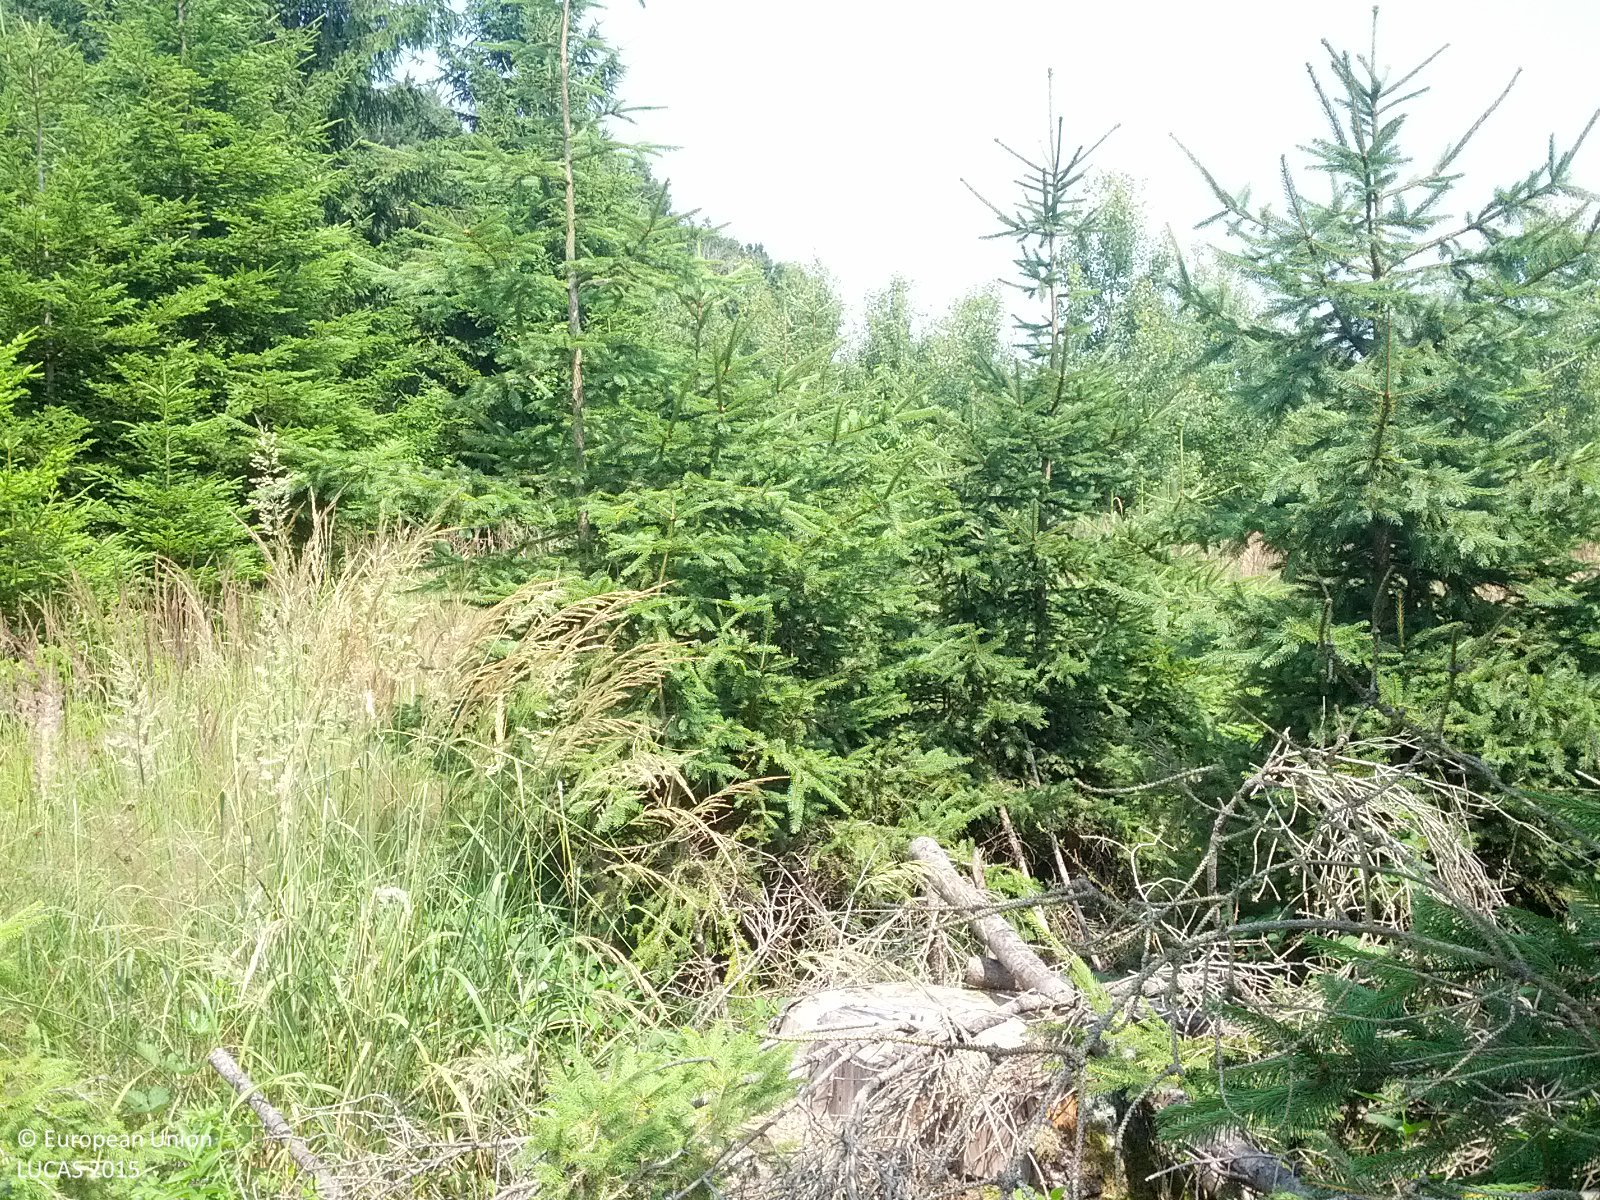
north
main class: Woodland
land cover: Spruce dominated coniferous woodland
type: alpine coniferous forest
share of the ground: > 75 %
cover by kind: coniferous forest trees 80 %, herbaceous plants 10 %, unconsolidated bare surface 10 %
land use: Forestry
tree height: > 5 m
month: July
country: AT
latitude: 47.2399
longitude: 16.1448
